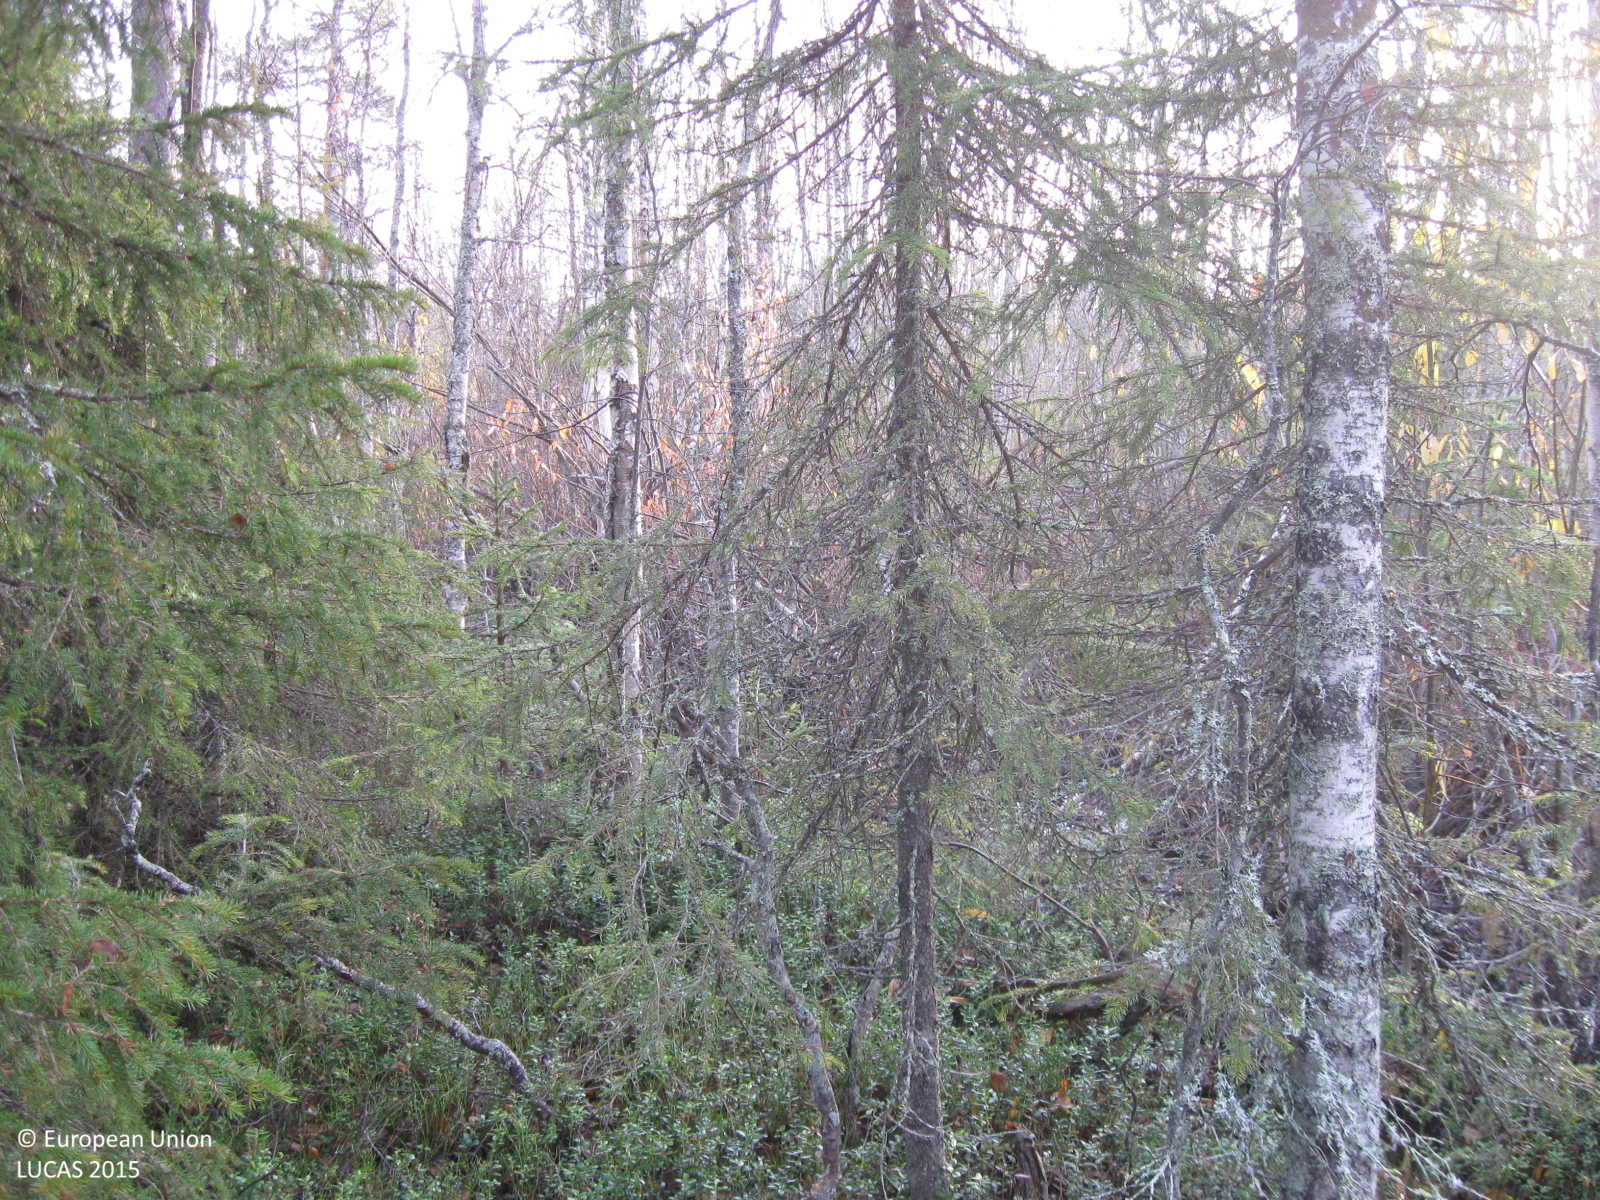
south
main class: Woodland
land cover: Spruce dominated mixed woodland
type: boreal forest
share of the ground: > 75 %
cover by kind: broadleaved forest trees 65 %, coniferous forest trees 25 %, shrubs 5 %, herbaceous plants 5 %
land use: Forestry
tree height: > 5 m
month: October
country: SE
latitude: 66.3873
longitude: 21.6212
